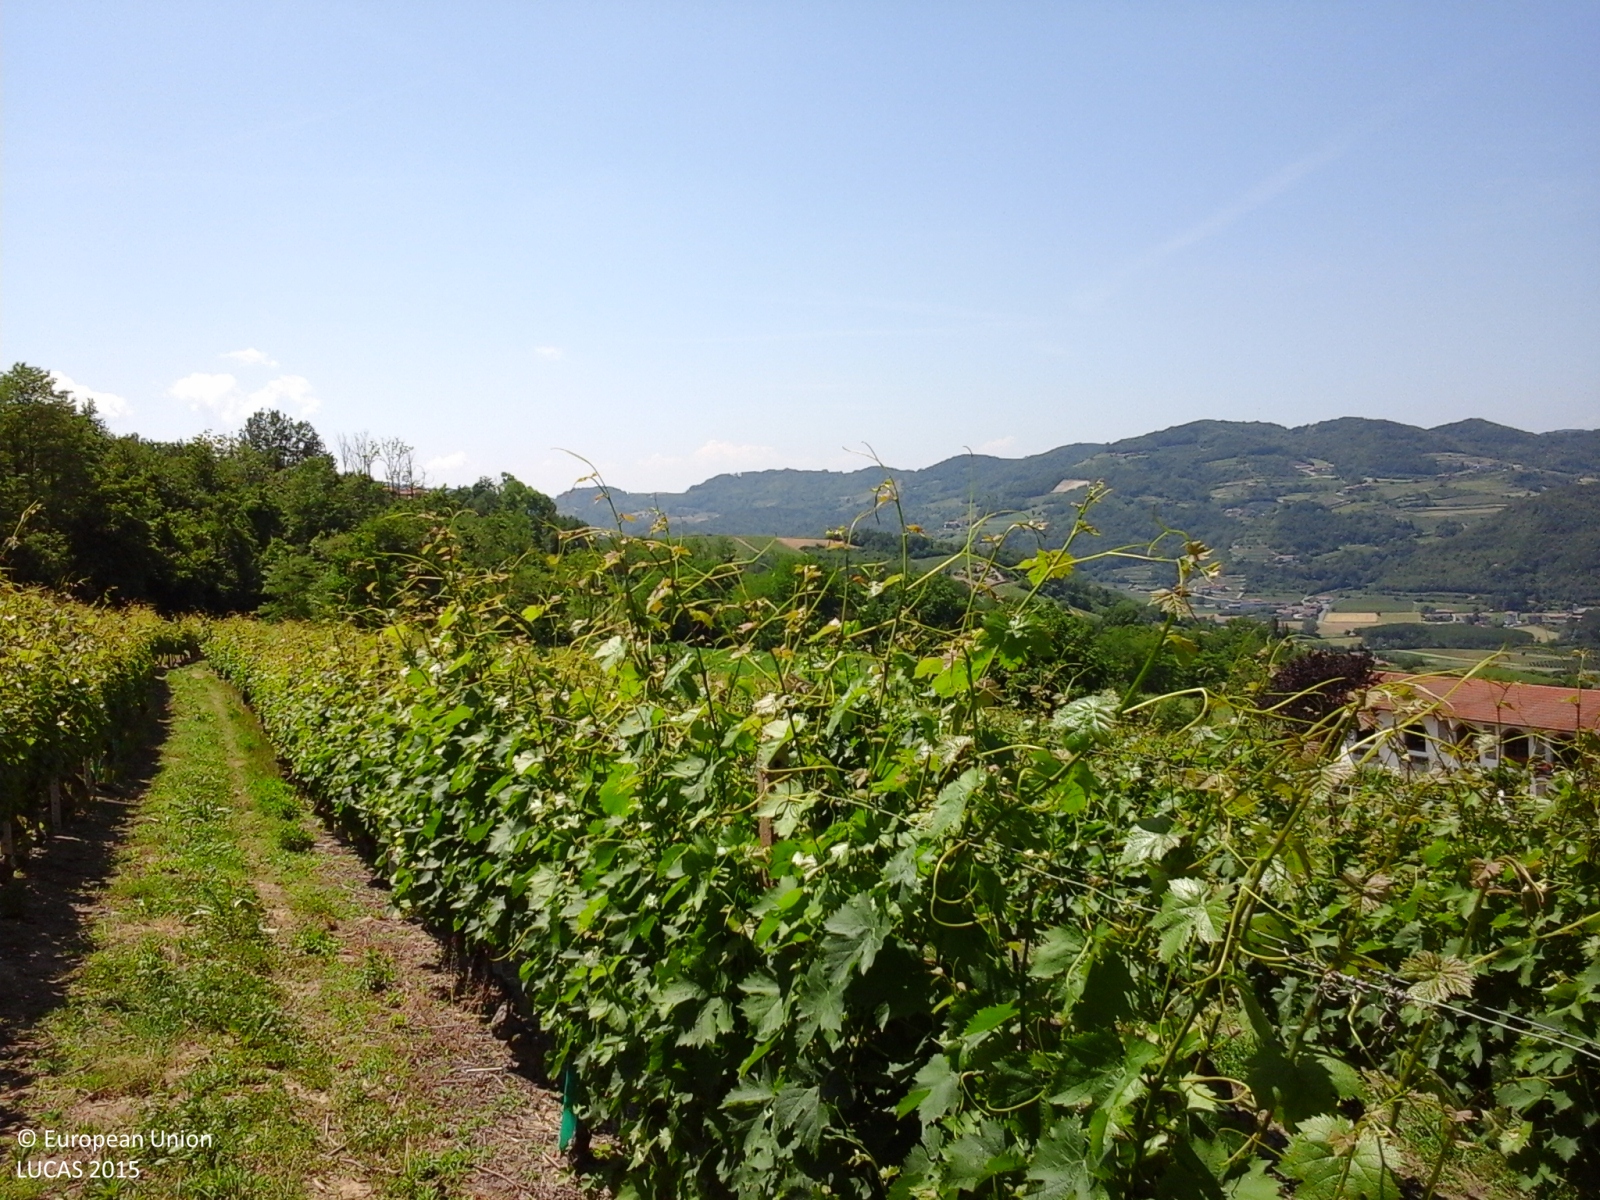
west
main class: Cropland
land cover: Vineyards
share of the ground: 50 - 75 %
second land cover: Grassland without tree/shrub cover
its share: > 75 %
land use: Agriculture (excluding fallow land and kitchen gardens)
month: June
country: IT
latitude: 44.6245
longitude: 8.2517
